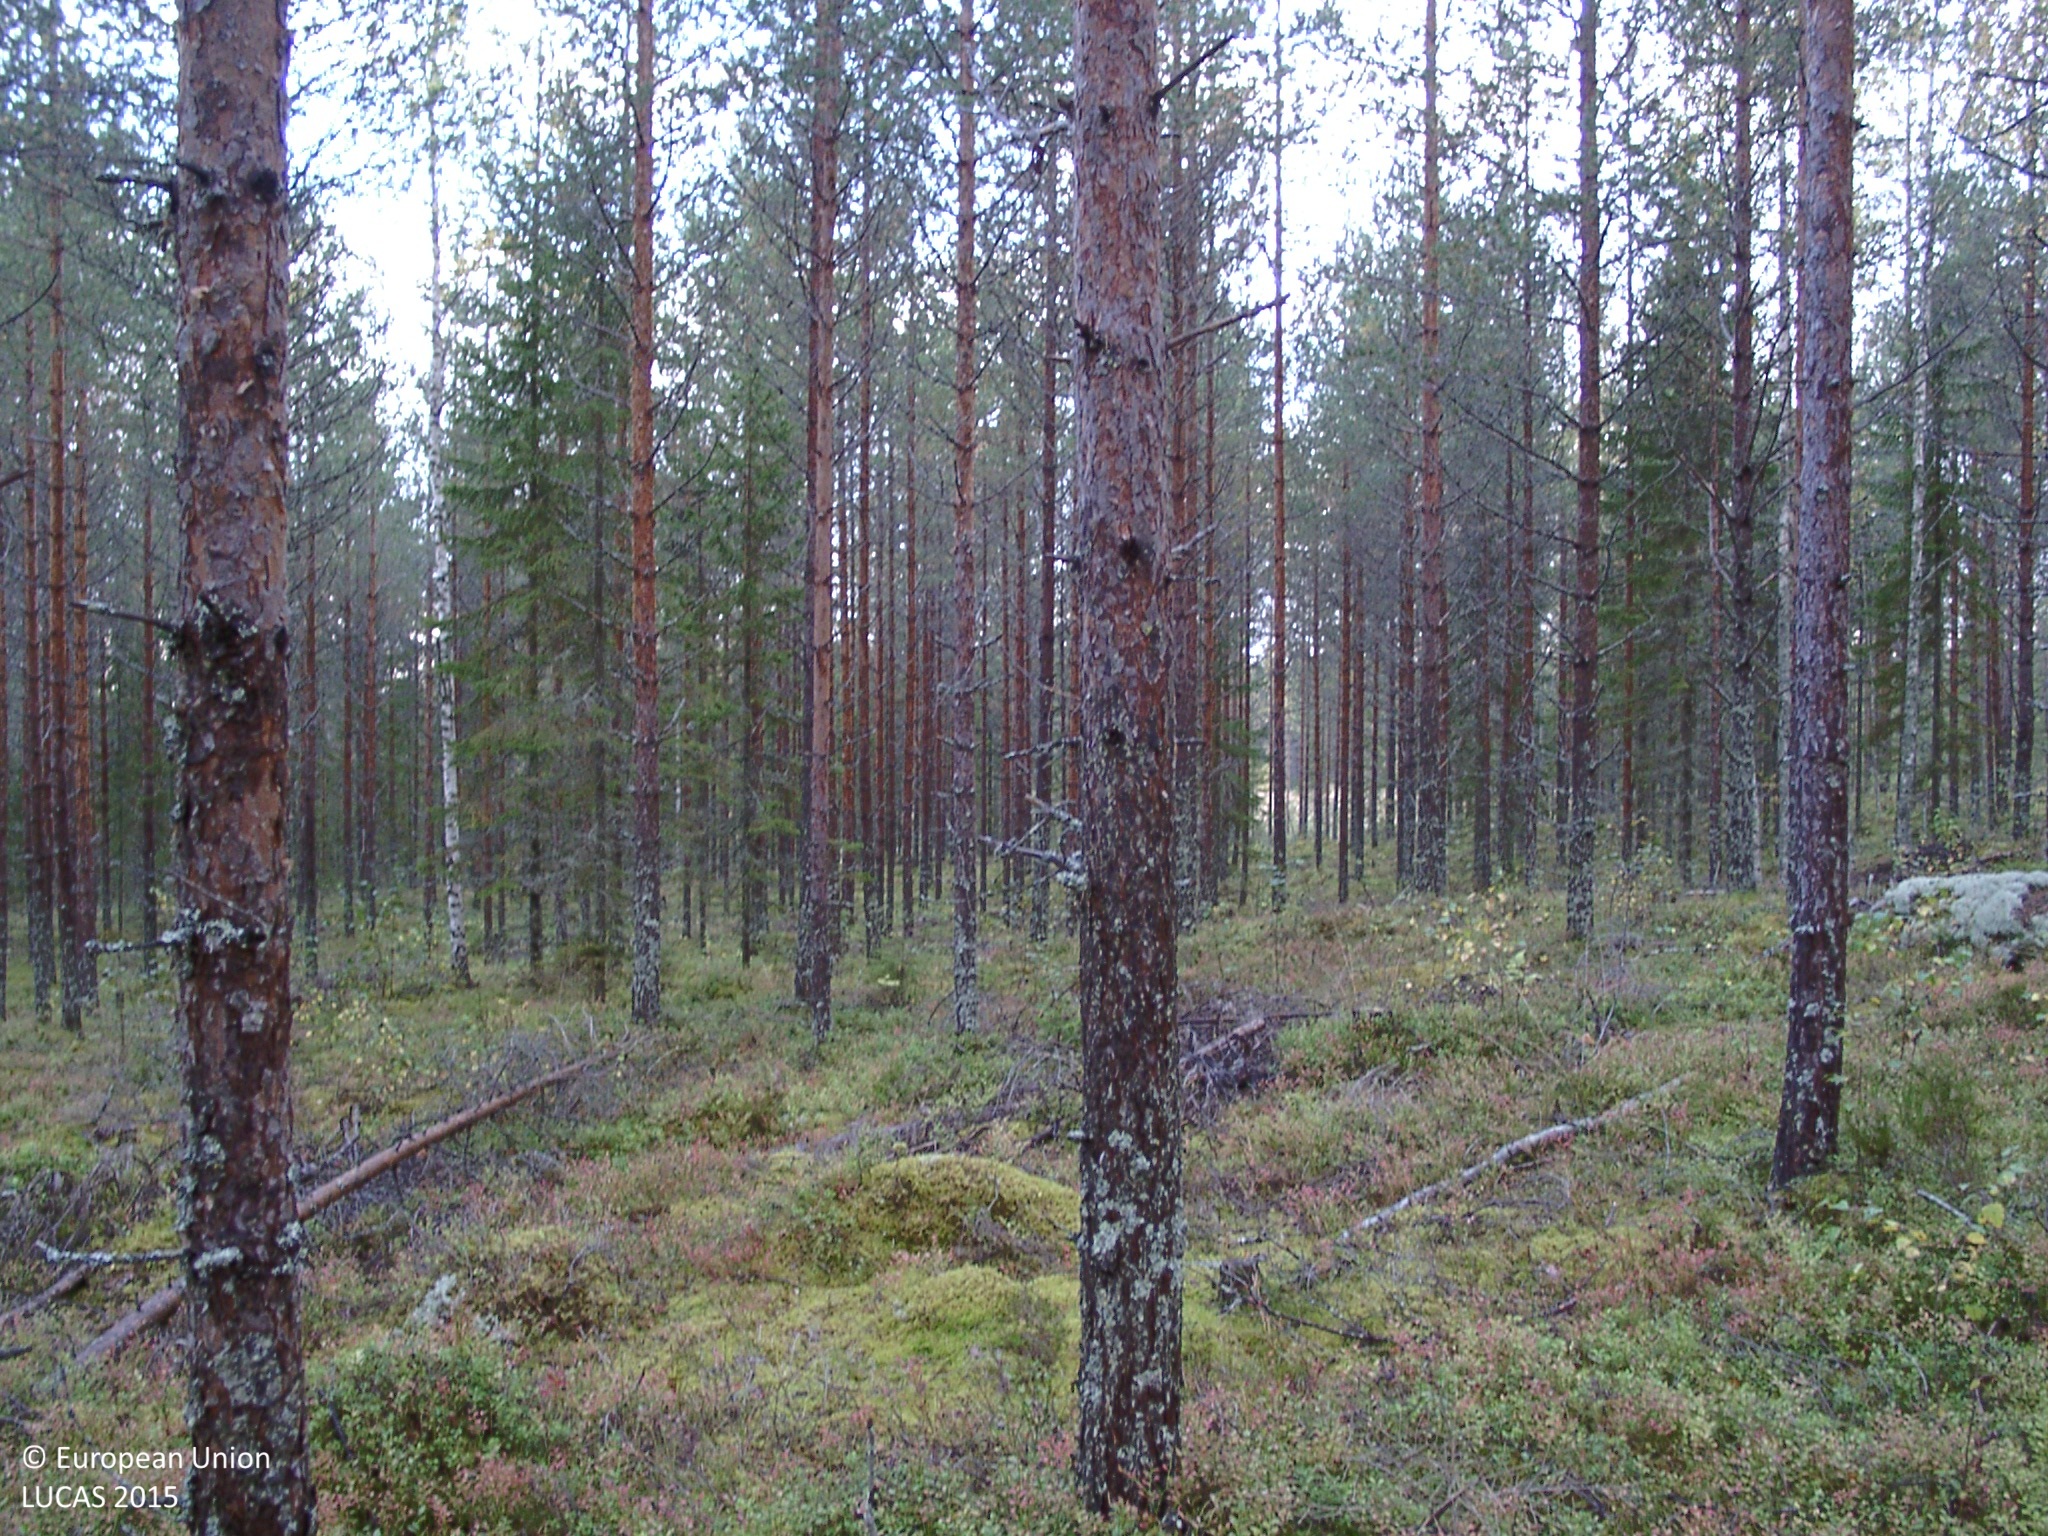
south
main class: Woodland
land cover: Pine dominated coniferous woodland
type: boreal forest
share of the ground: 50 - 75 %
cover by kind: coniferous forest trees 65 %, lichens and mosses 20 %, shrubs 15 %
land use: Forestry
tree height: > 5 m
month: September
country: FI
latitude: 62.7380
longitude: 25.5502
